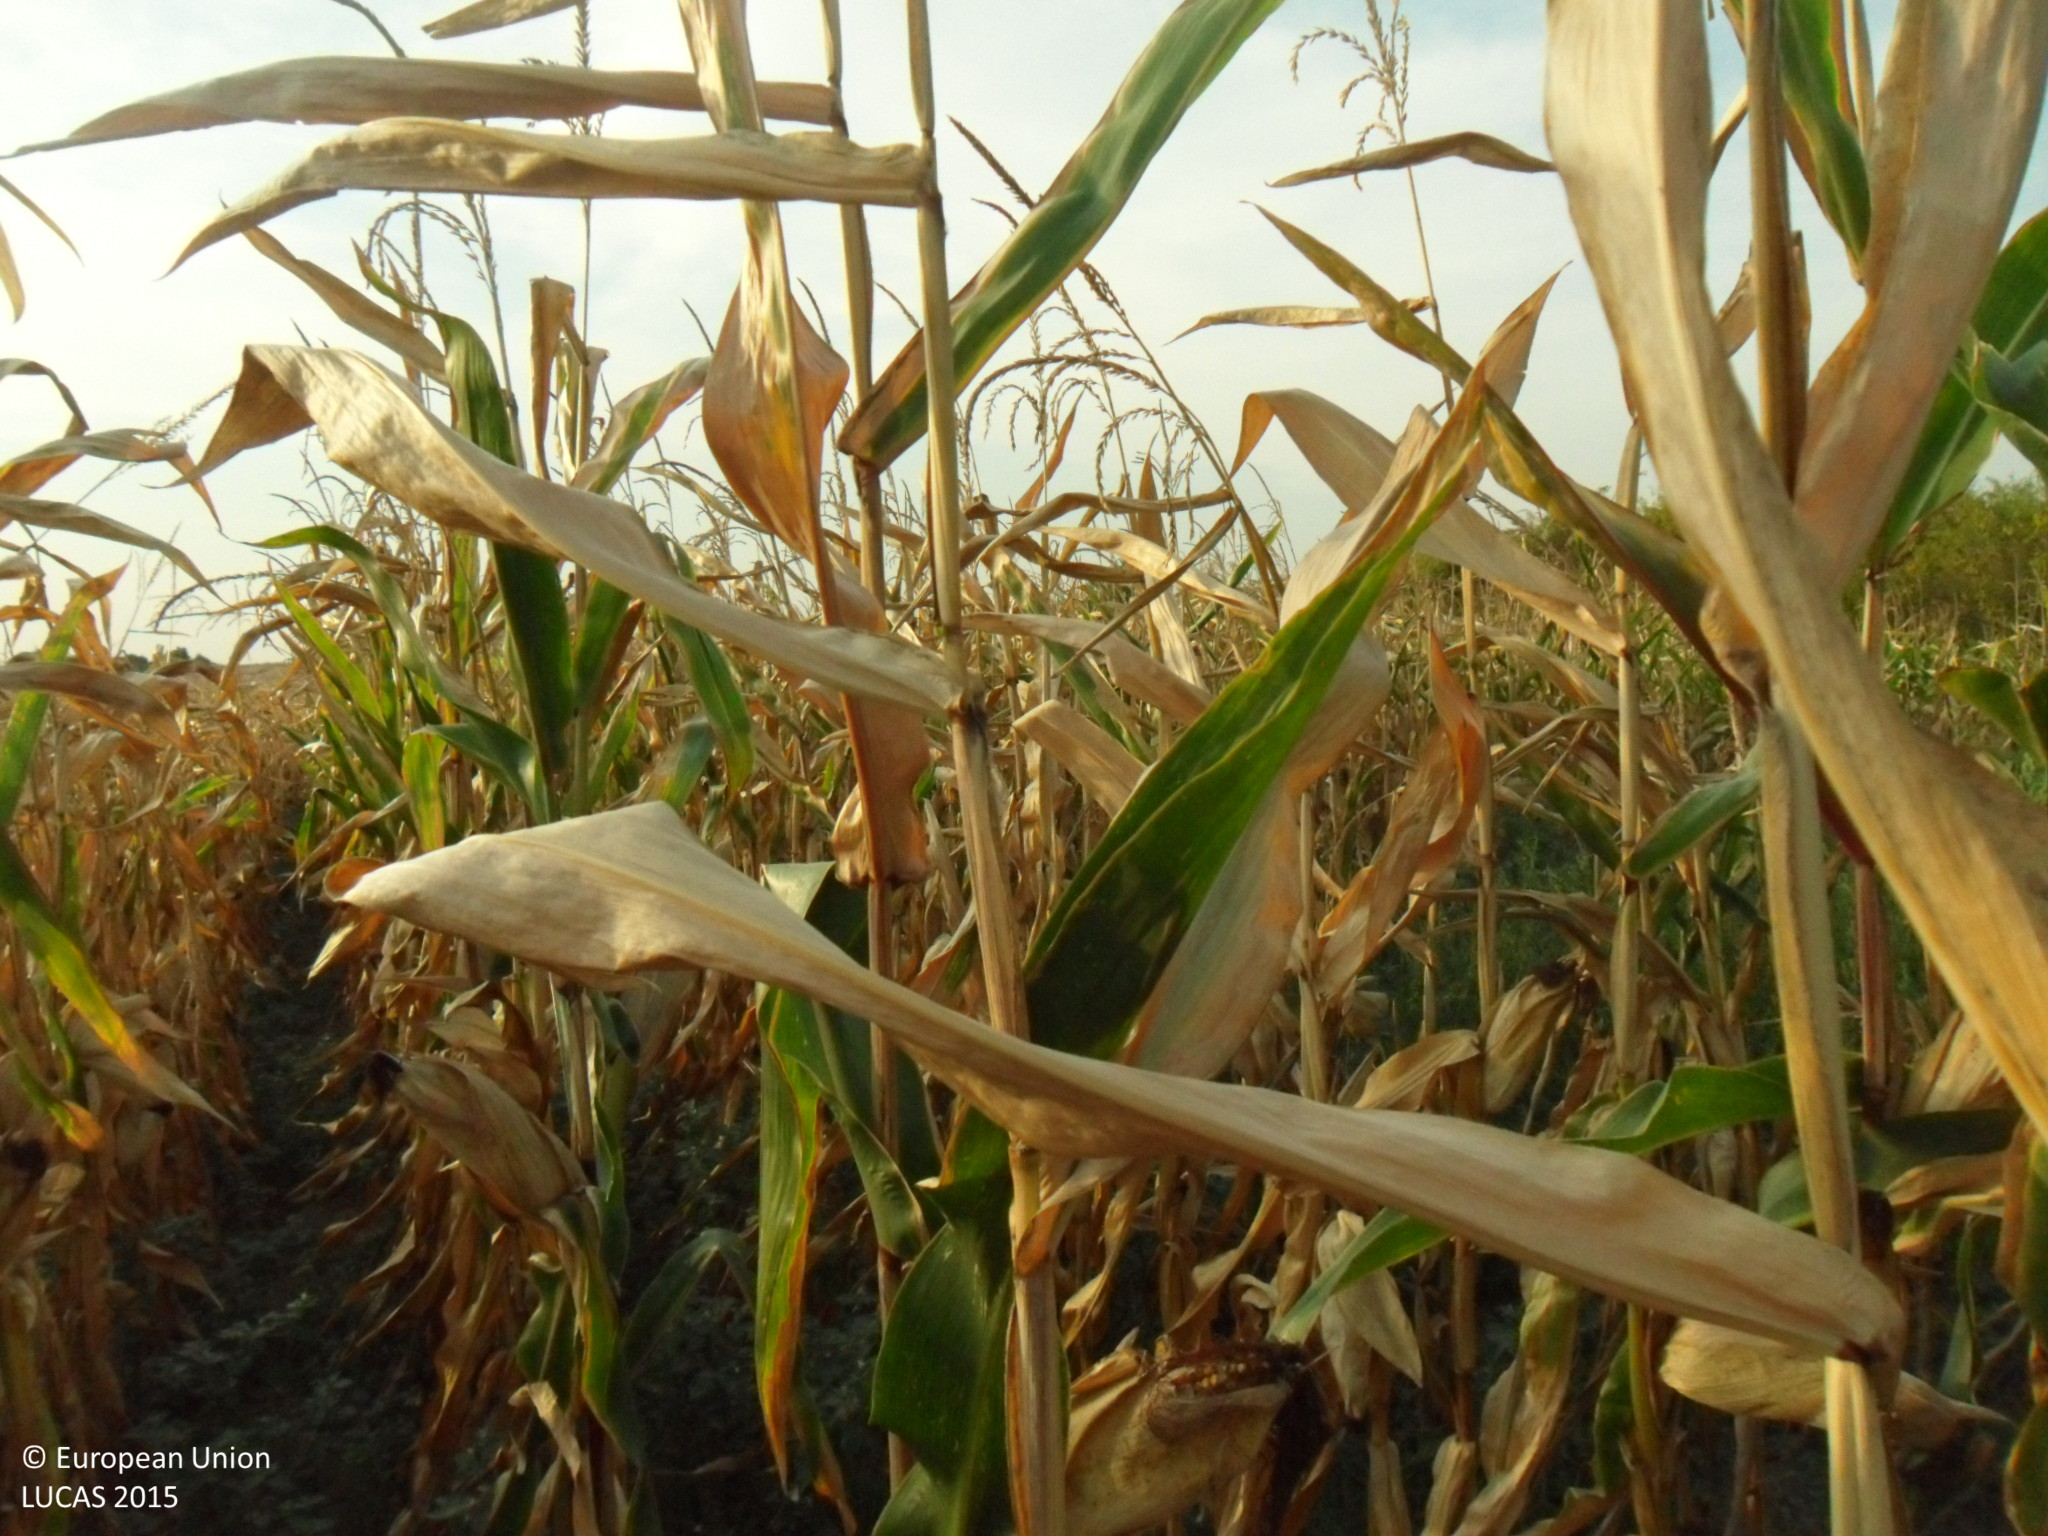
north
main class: Cropland
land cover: Maize
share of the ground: > 75 %
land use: Agriculture (excluding fallow land and kitchen gardens)
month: September
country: BG
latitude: 43.5840
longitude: 26.1856
